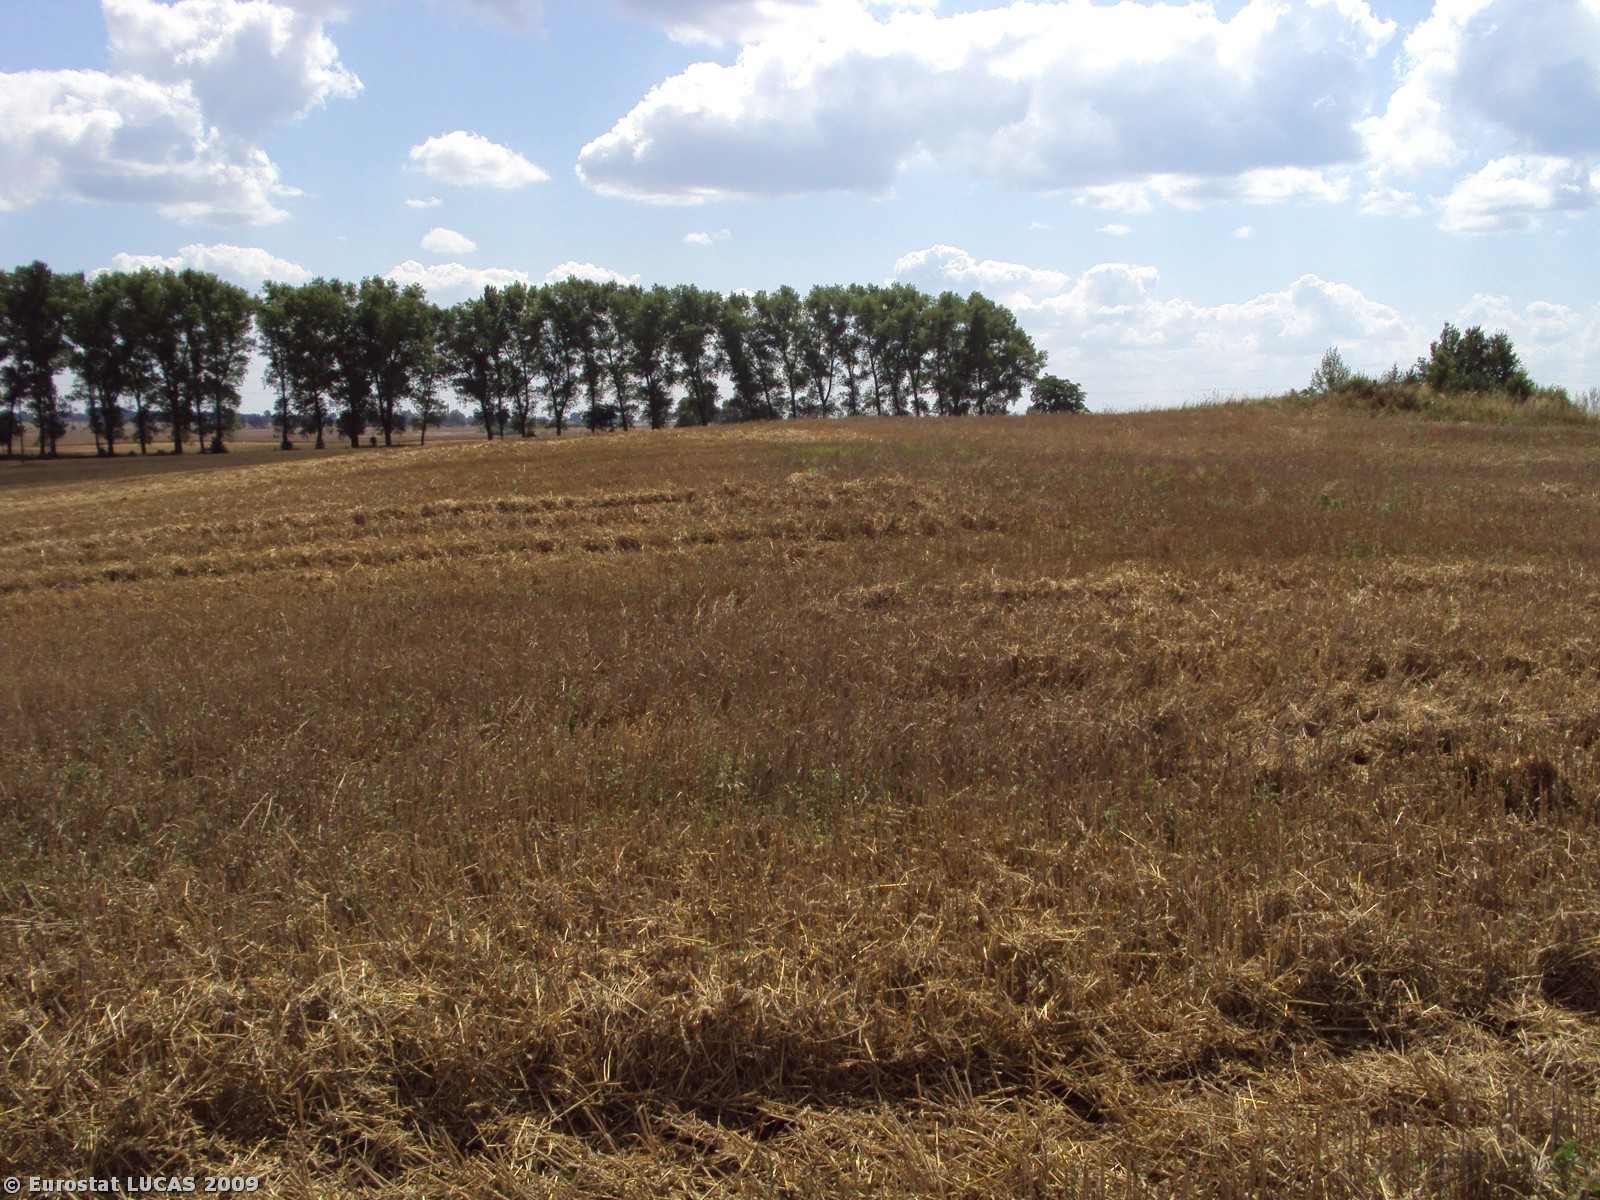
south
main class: Cropland
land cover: Common wheat
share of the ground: < 10 %
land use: Agriculture (excluding fallow land and kitchen gardens)
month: August
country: PL
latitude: 53.2146
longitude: 16.4010
